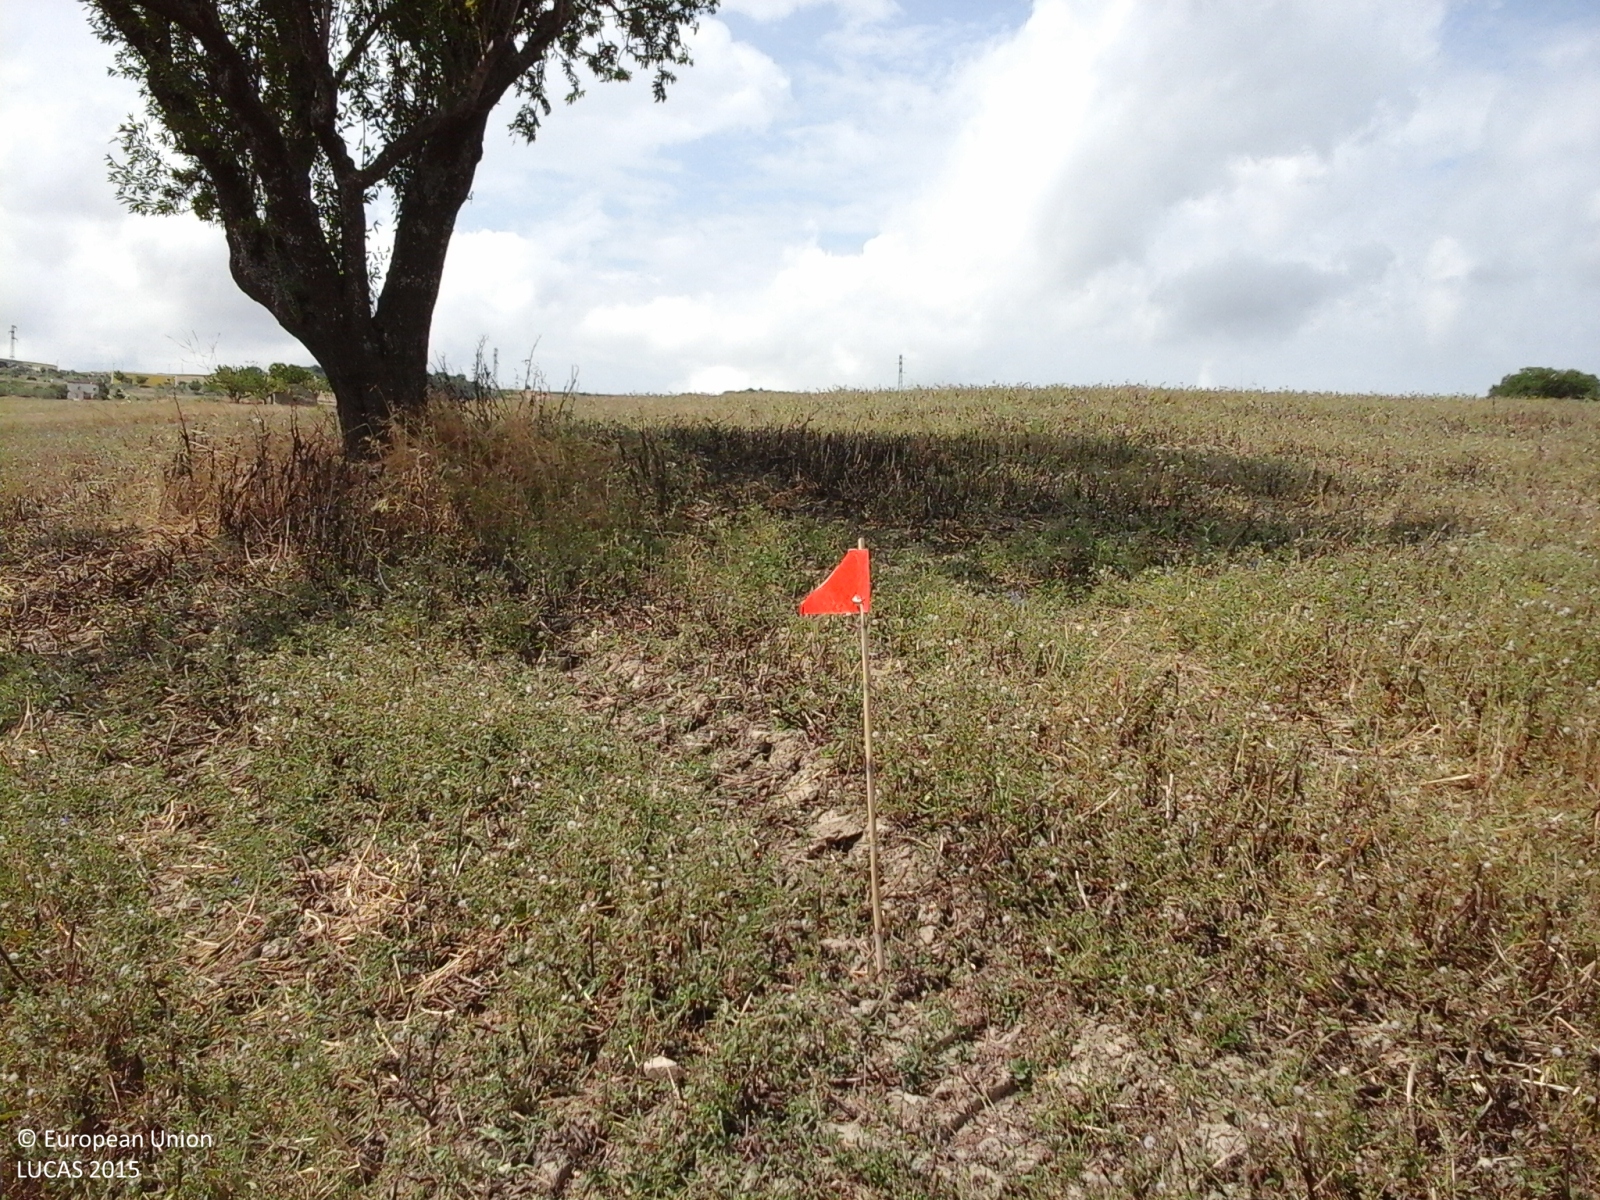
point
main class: Cropland
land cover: Dry pulses
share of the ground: > 75 %
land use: Agriculture (excluding fallow land and kitchen gardens)
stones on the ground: < 10 %
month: July
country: IT
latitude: 41.8035
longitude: 14.6906
